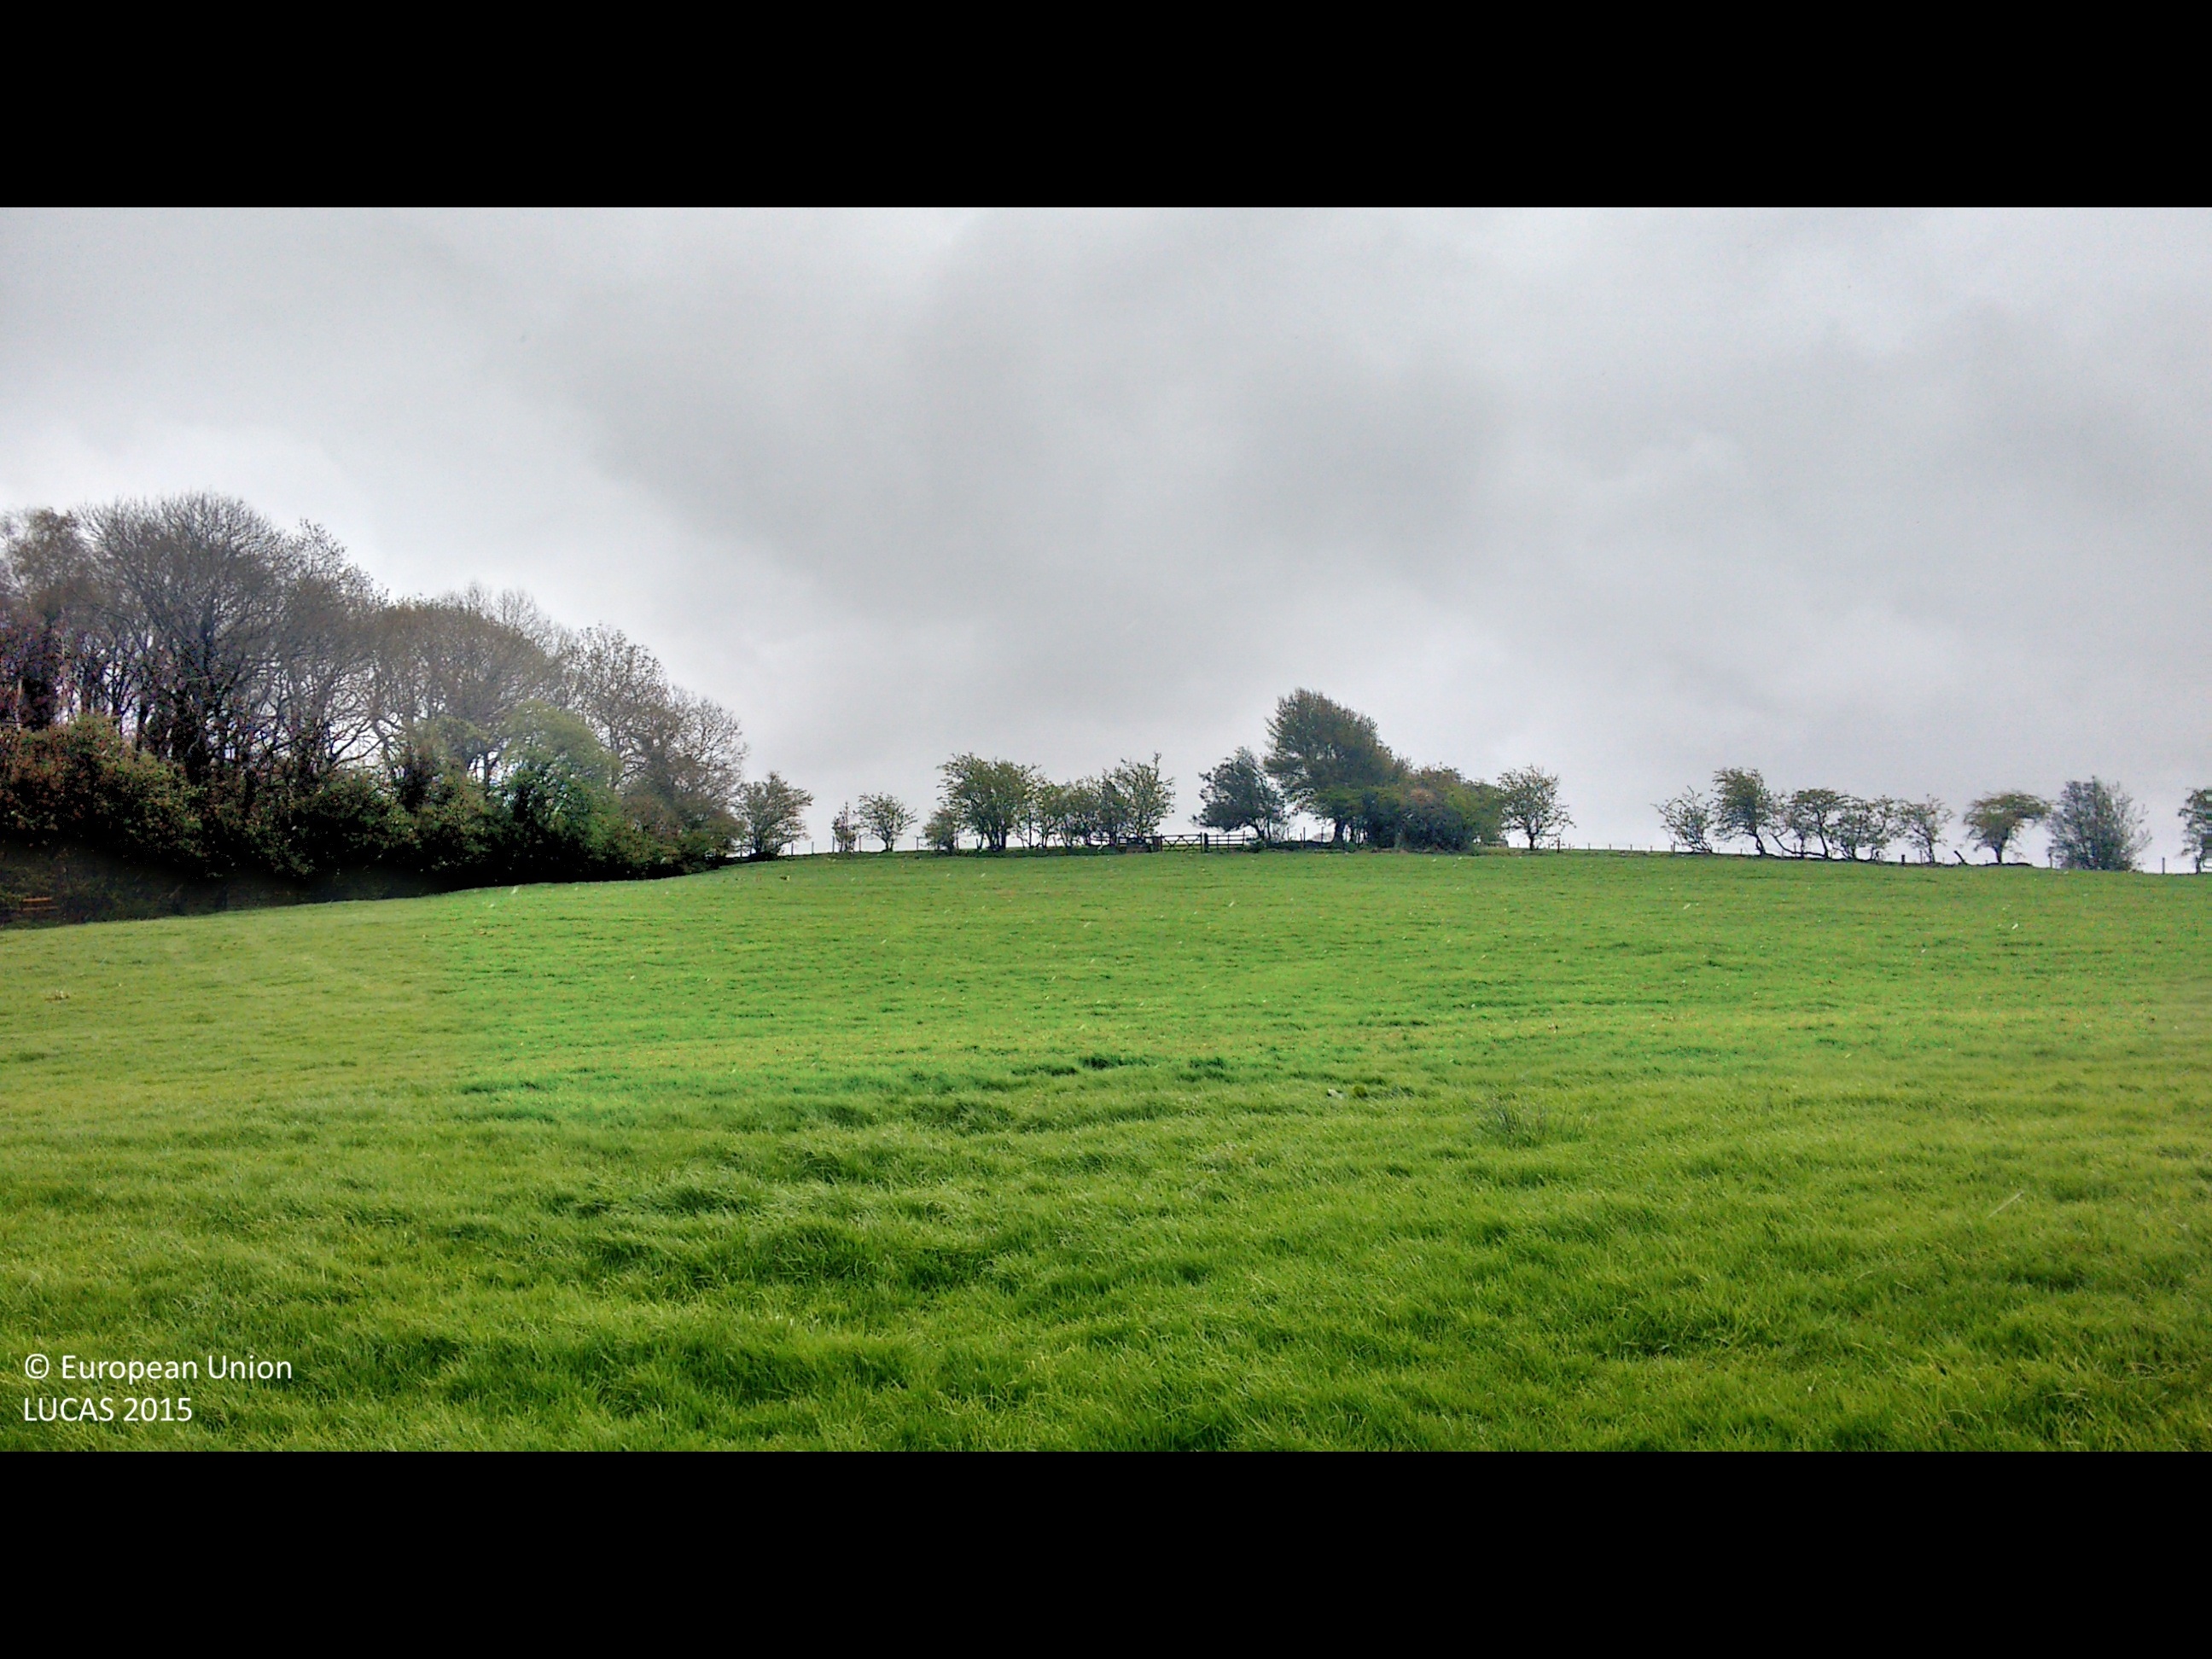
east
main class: Grassland
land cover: Grassland without tree/shrub cover
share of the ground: > 75 %
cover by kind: herbaceous plants 100 %
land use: Agriculture (excluding fallow land and kitchen gardens)
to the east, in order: Grassland without tree/shrub cover; Fences; Broadleaved woodland; Fences; Grassland without tree/shrub cover
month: May
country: GB
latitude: 54.1069
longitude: -2.5926
